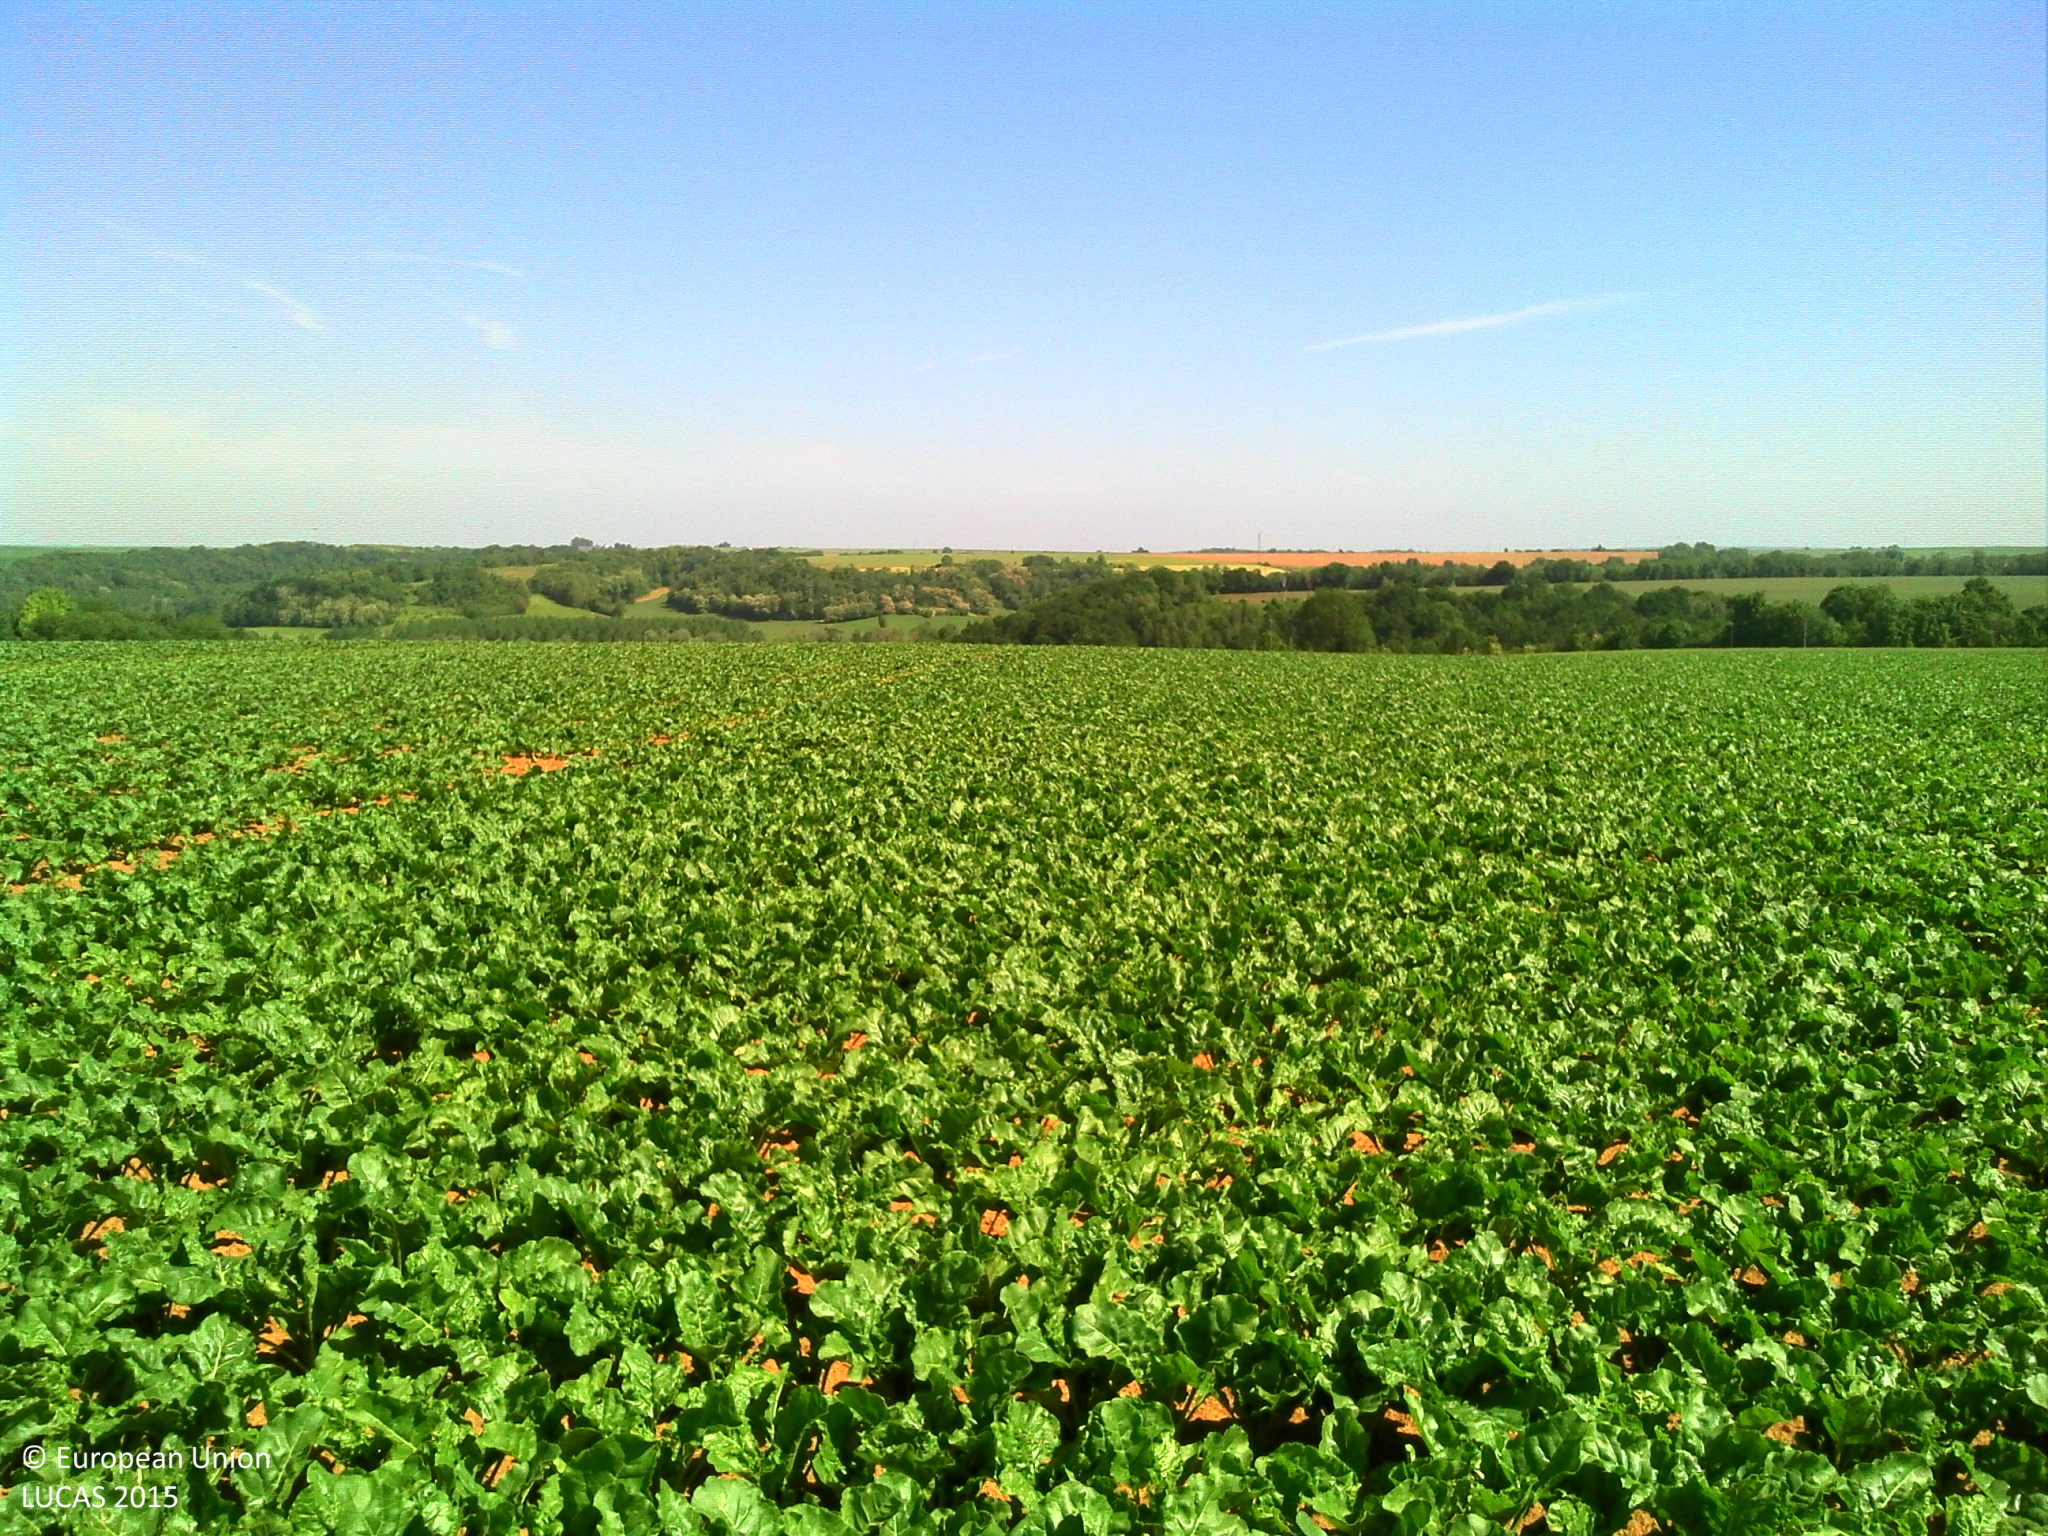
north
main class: Cropland
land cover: Sugar beet
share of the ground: > 75 %
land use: Agriculture (excluding fallow land and kitchen gardens)
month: June
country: FR
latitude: 49.4442
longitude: 3.2751
